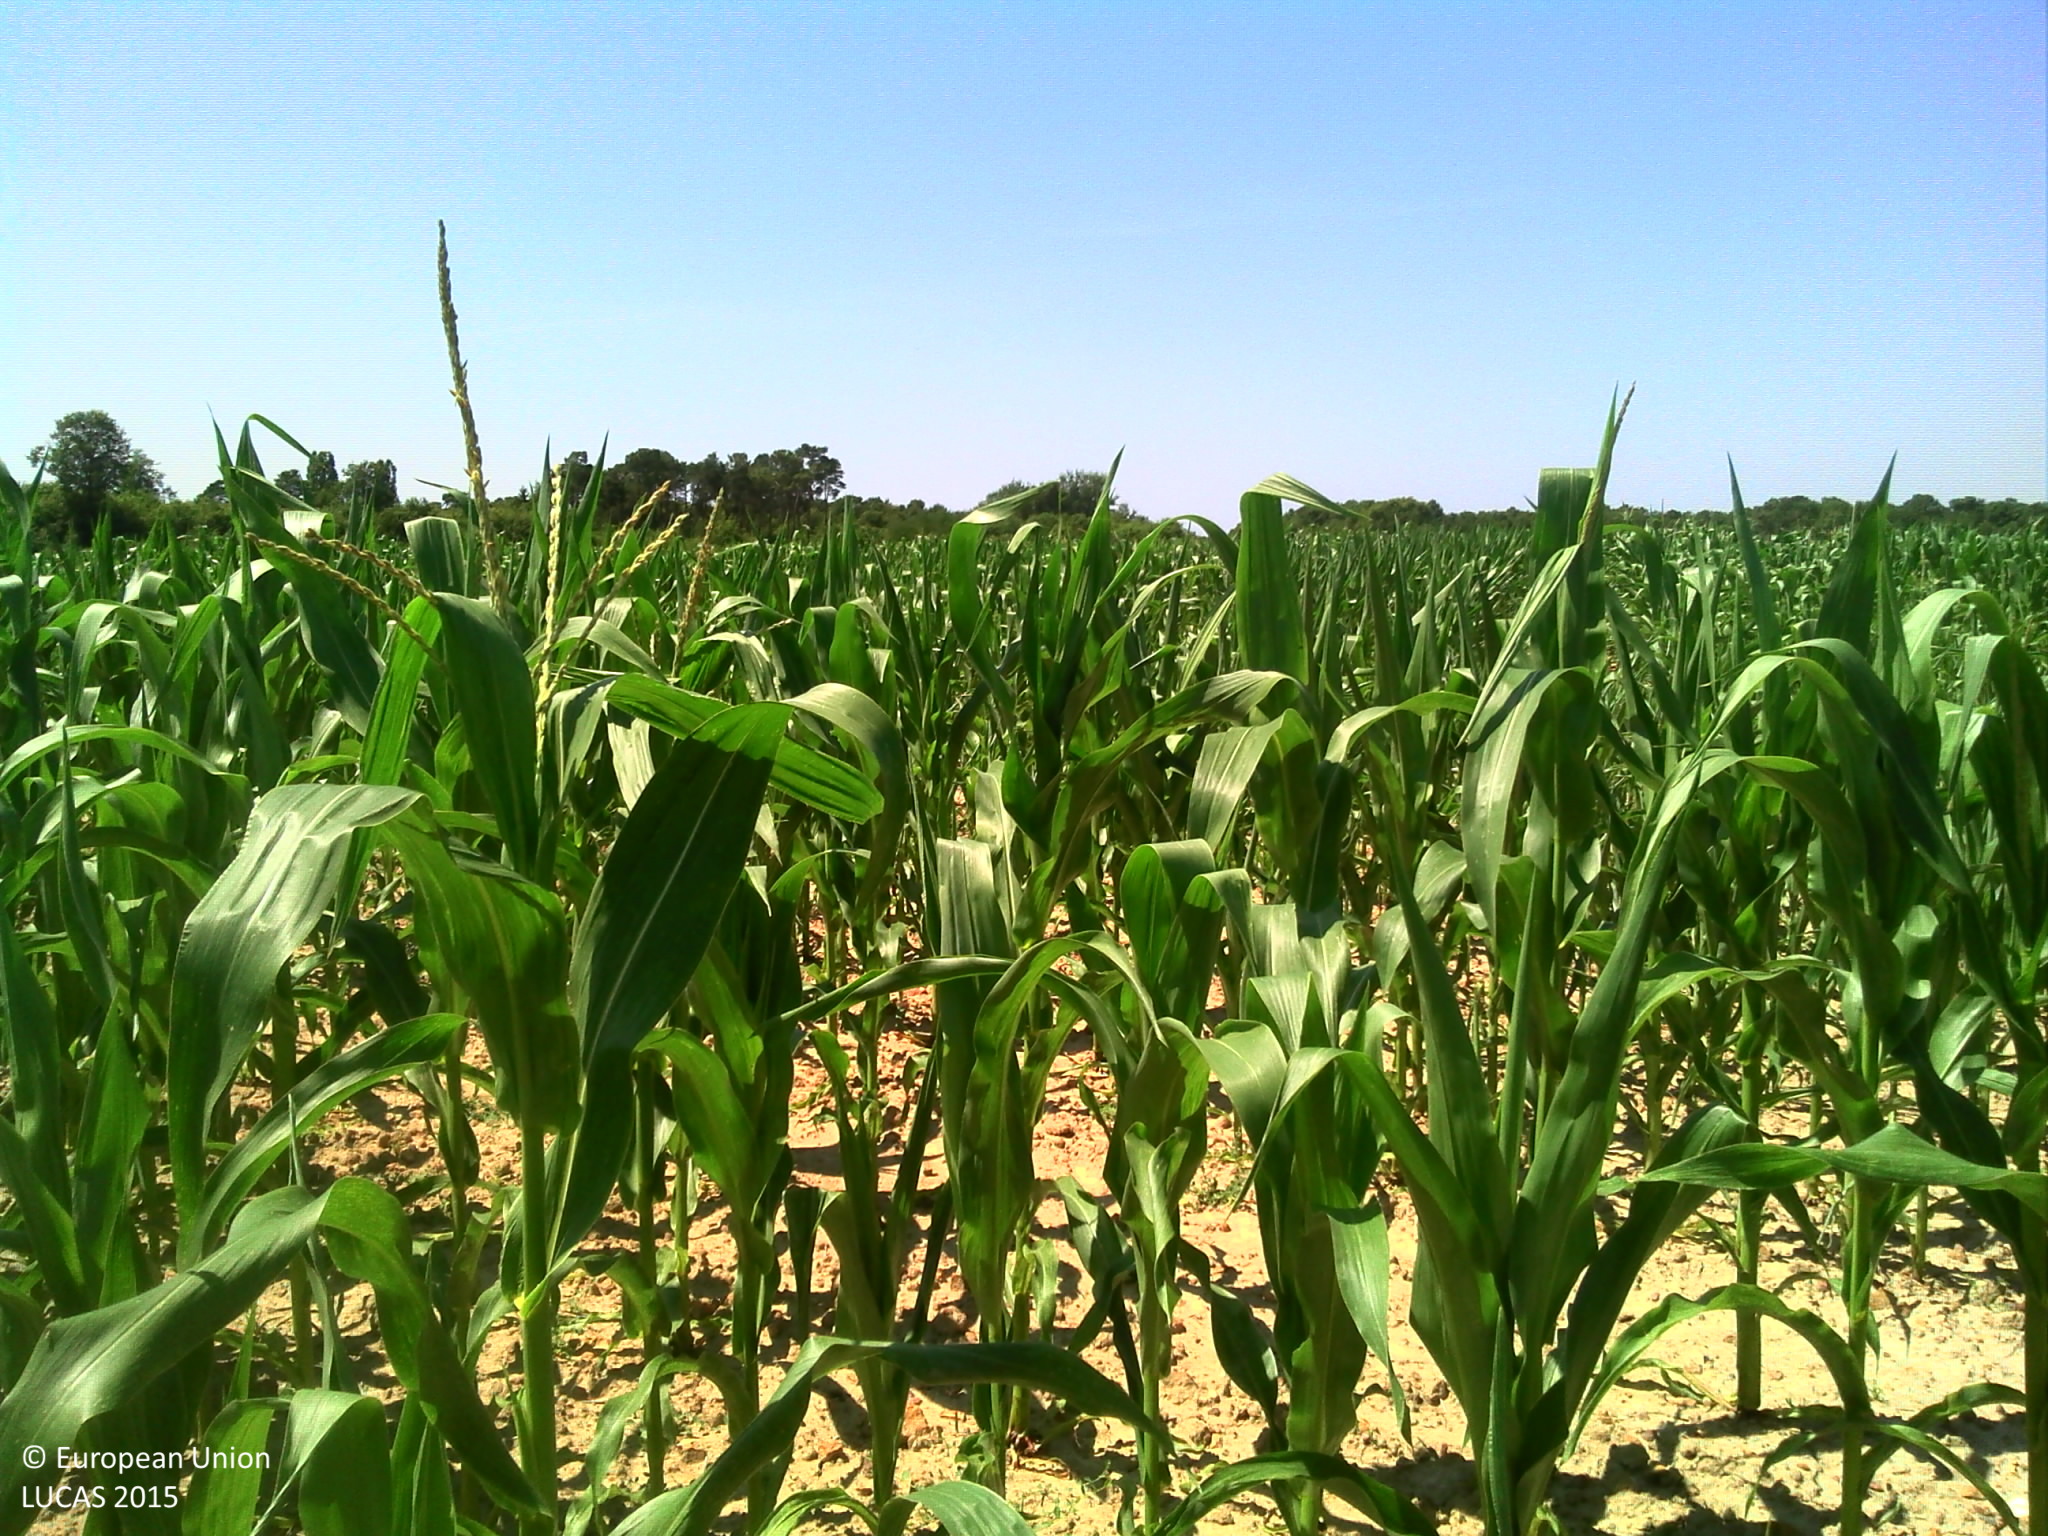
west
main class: Cropland
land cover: Maize
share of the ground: 25 - 50 %
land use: Agriculture (excluding fallow land and kitchen gardens)
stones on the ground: 10 - 25 %
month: July
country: FR
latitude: 47.2182
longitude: 0.7515
